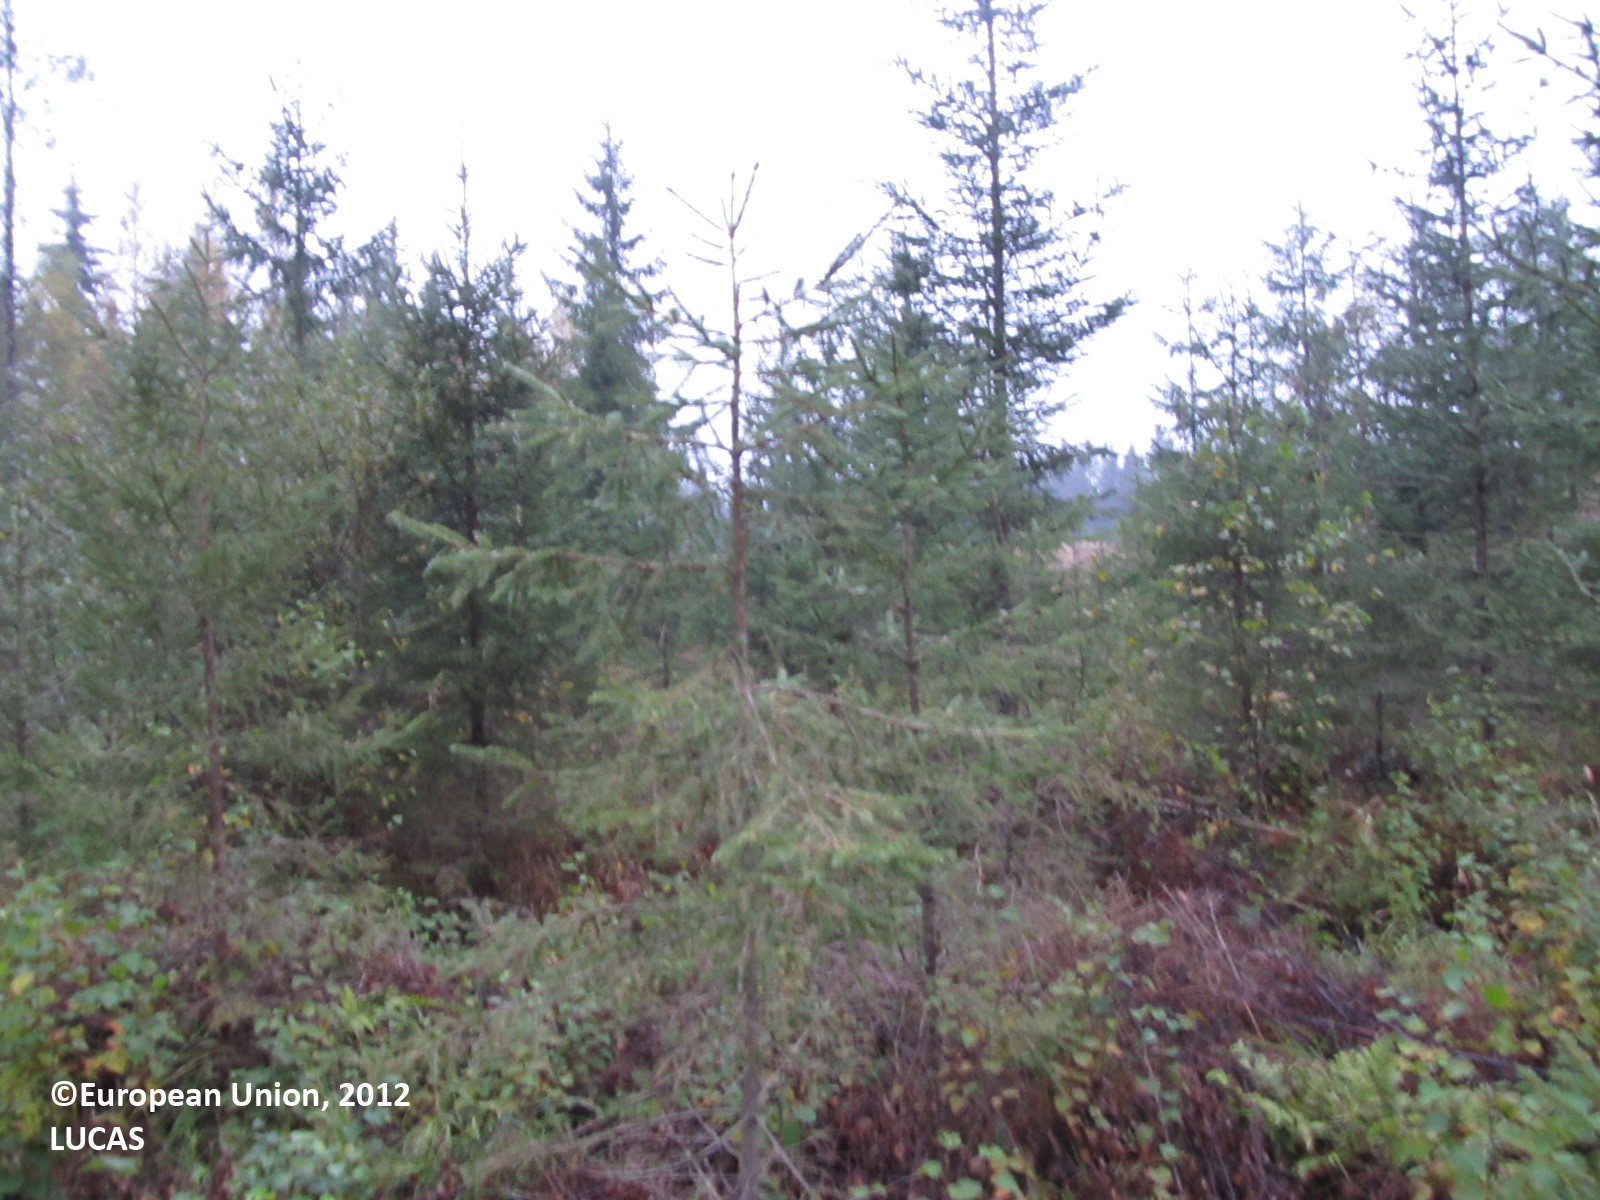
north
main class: Woodland
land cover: Spruce dominated mixed woodland
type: boreal forest
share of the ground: 50 - 75 %
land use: Forestry
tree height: < 5 m
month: September
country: FI
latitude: 62.2855
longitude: 28.2149
